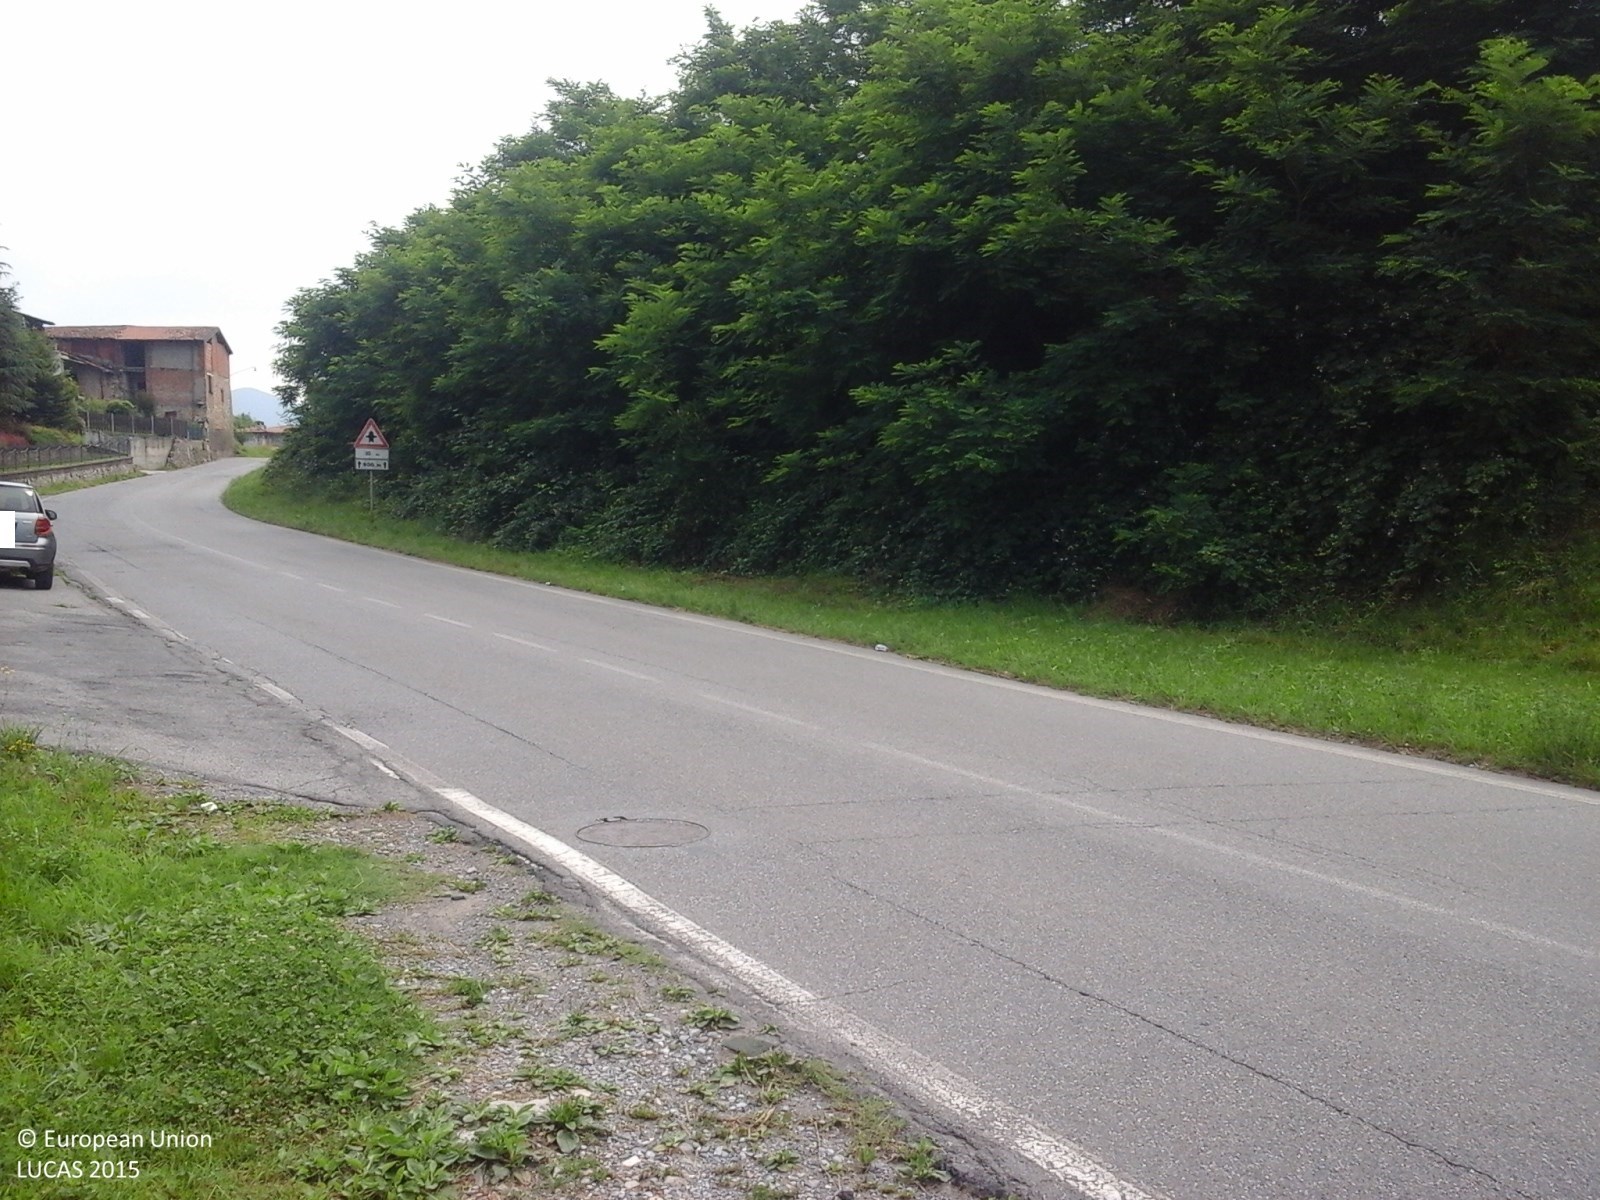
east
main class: Grassland
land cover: Grassland without tree/shrub cover
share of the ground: > 75 %
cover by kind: herbaceous plants 100 %
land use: Construction
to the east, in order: Grassland without tree/shrub cover; Artificial constructions in urban areas; Grass margins; Broadleaved woodland; Grassland without tree/shrub cover; Maize; Grassland without tree/shrub cover; Artificial constructions in urban areas; Grassland without tree/shrub cover
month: June
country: IT
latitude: 45.6666
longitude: 9.9103
